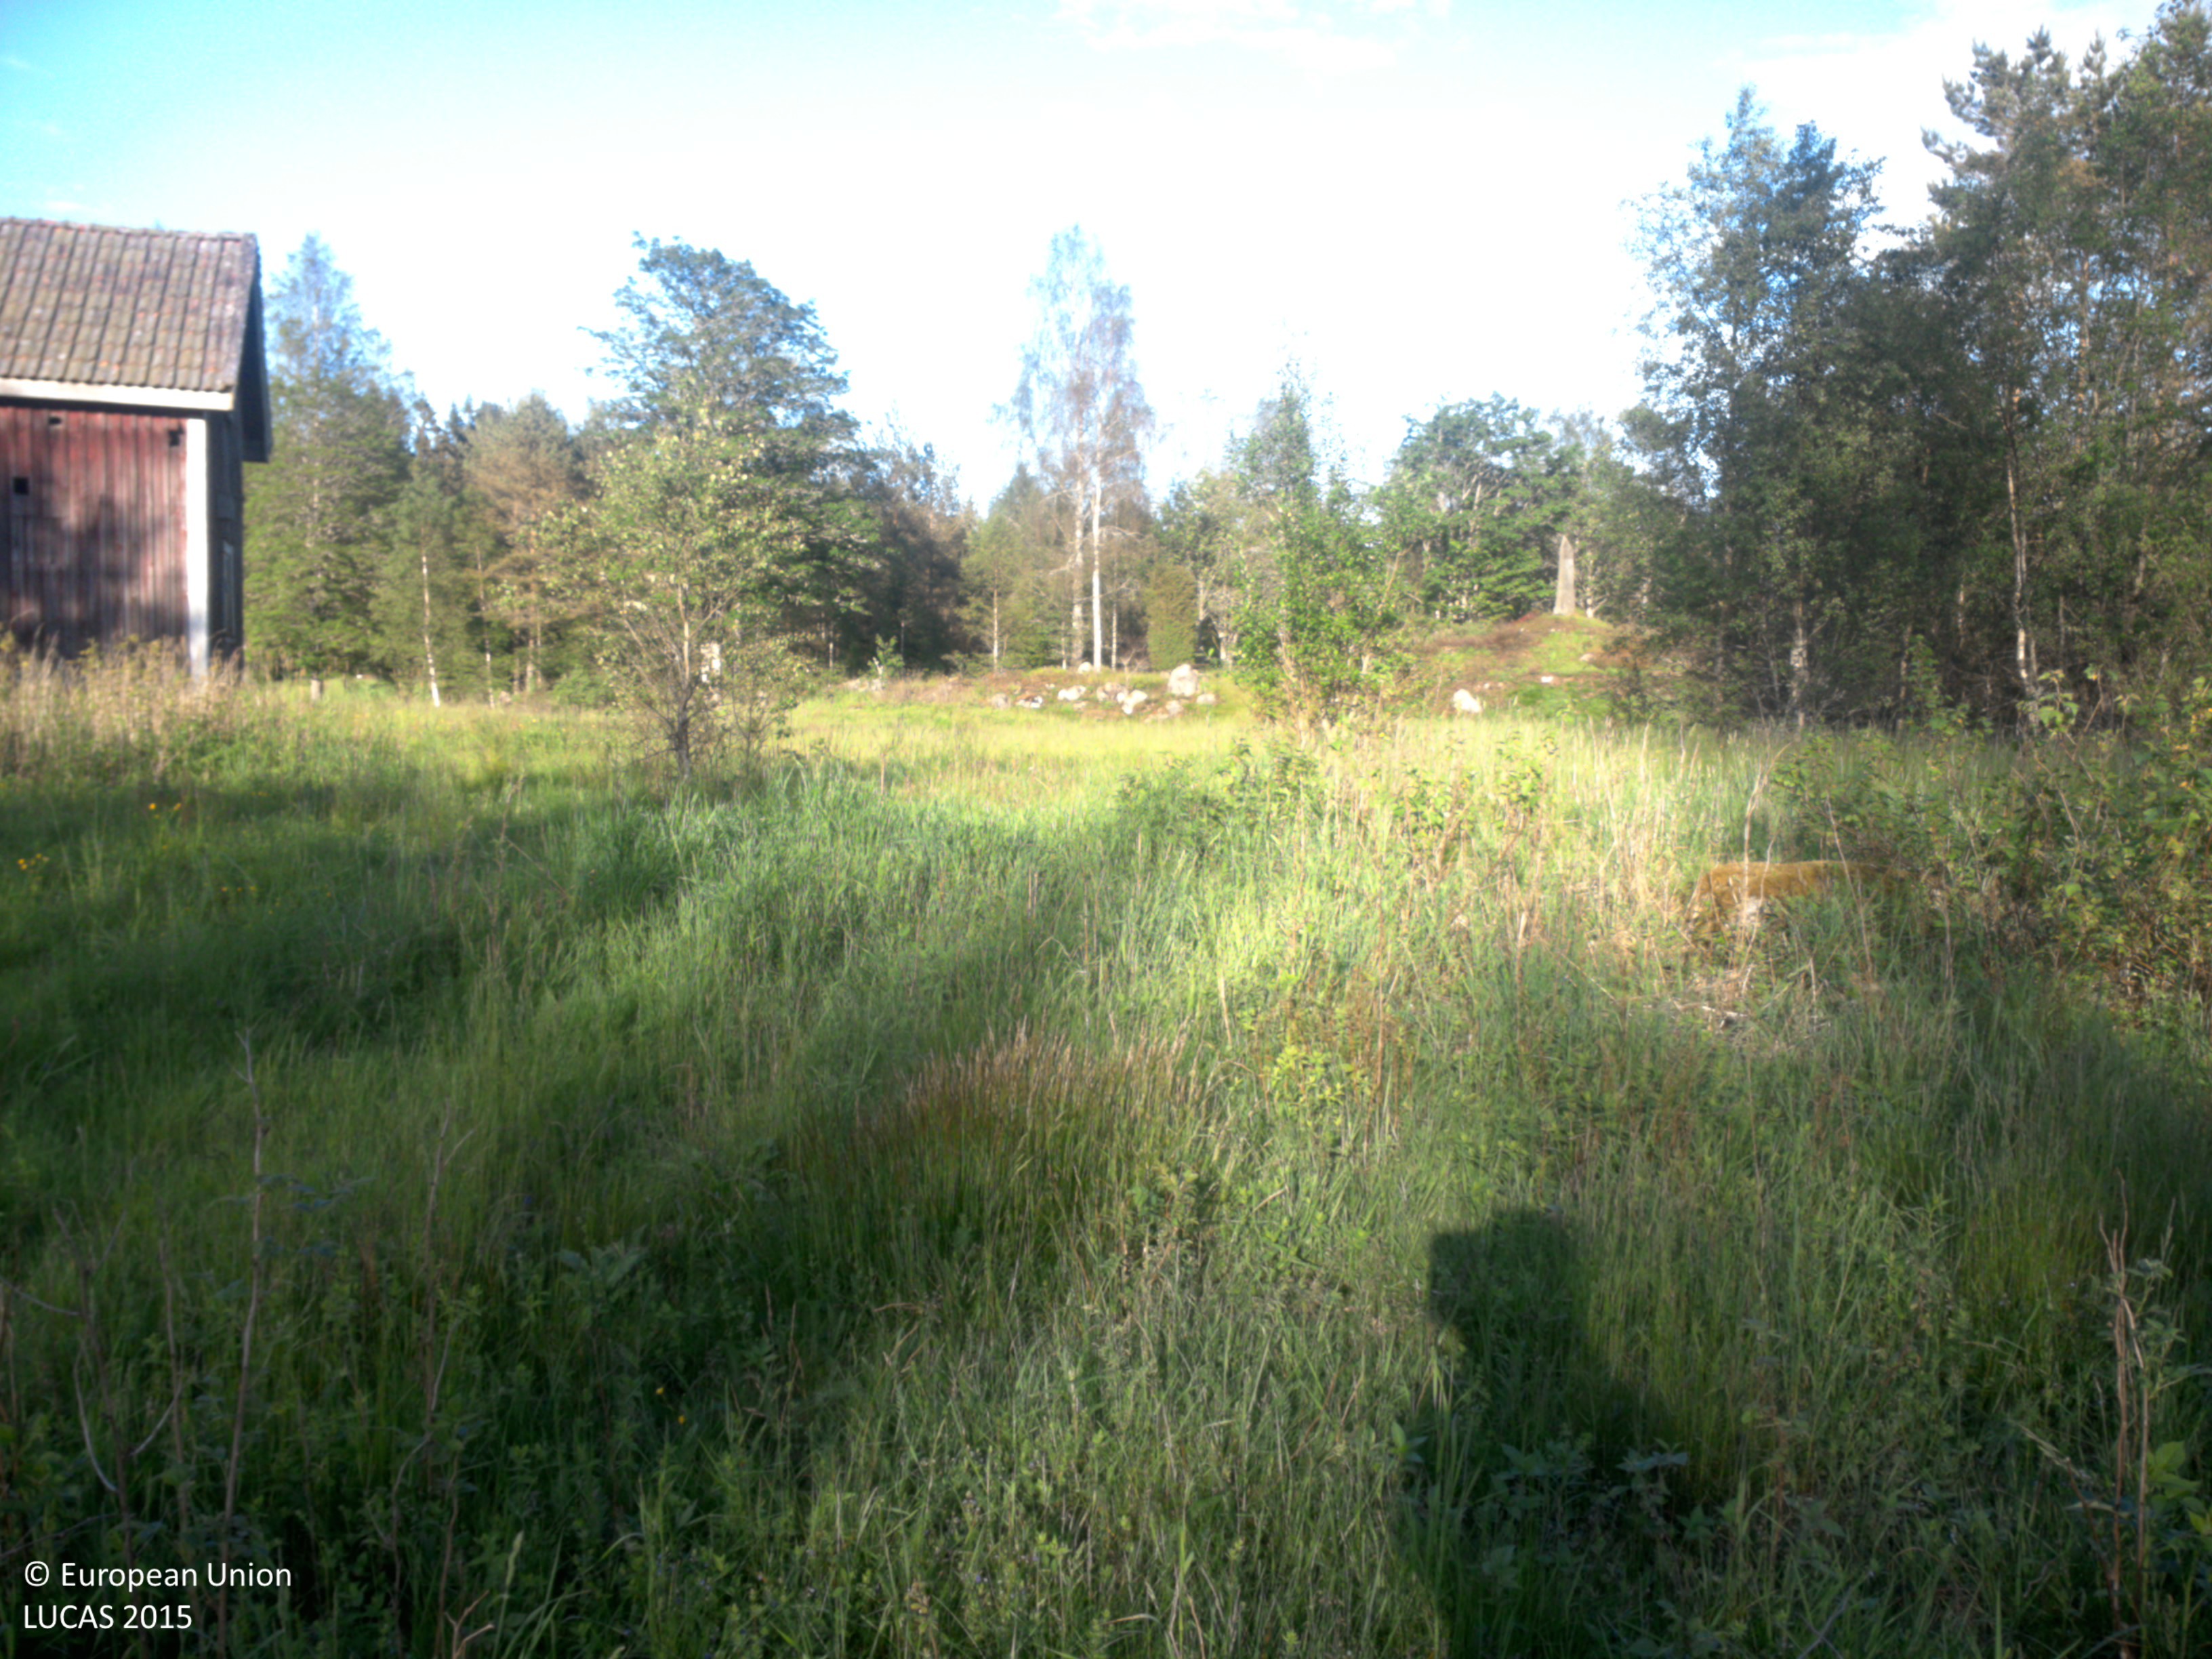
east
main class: Grassland
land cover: Spontaneously vegetated surfaces
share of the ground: > 75 %
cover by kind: herbaceous plants 95 %, shrubs 5 %
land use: Fallow land
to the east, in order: Spontaneously vegetated surfaces; Grassland with sparse tree/shrub cover; Tracks; Grassland without tree/shrub cover; Broadleaved woodland; Paved roads, cycling and walking lanes; Grassland without tree/shrub cover; Broadleaved woodland; Tracks; Broadleaved woodland; Tracks
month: June
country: SE
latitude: 58.9628
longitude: 11.8215
